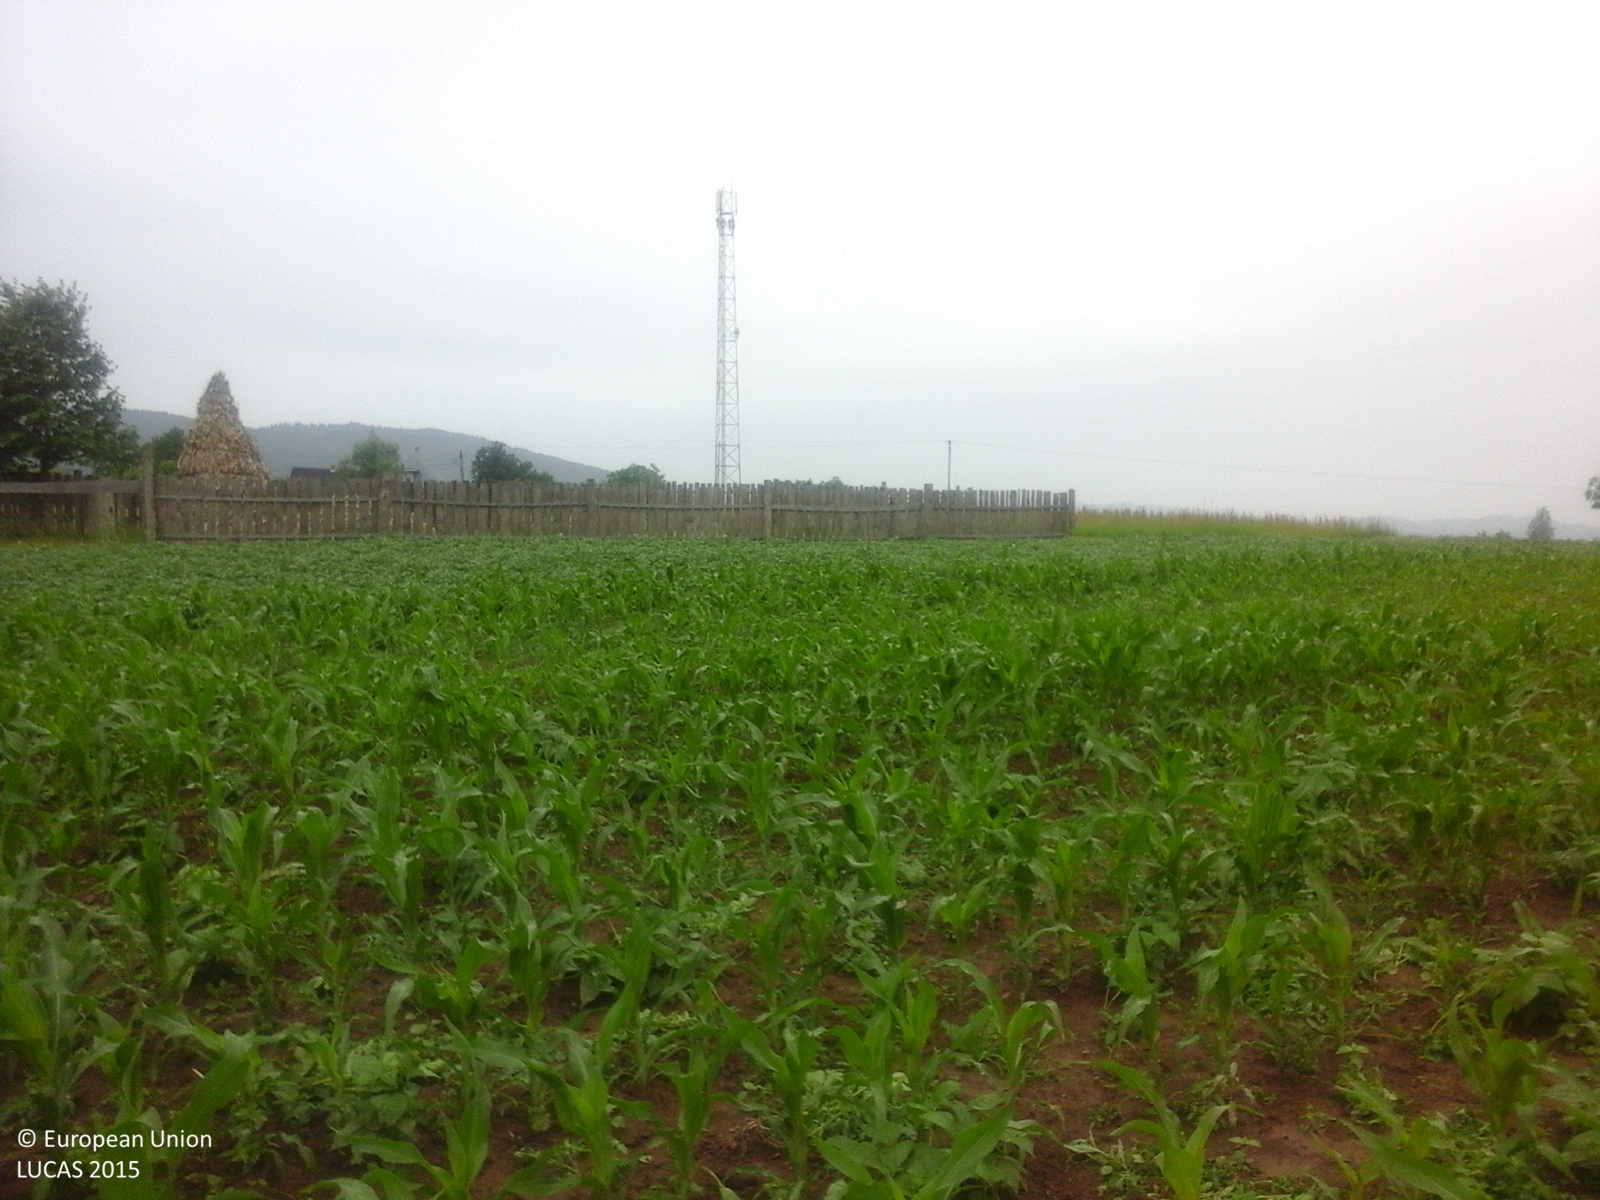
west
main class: Cropland
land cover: Maize
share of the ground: 25 - 50 %
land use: Agriculture (excluding fallow land and kitchen gardens)
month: June
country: RO
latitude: 47.8949
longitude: 25.7064
